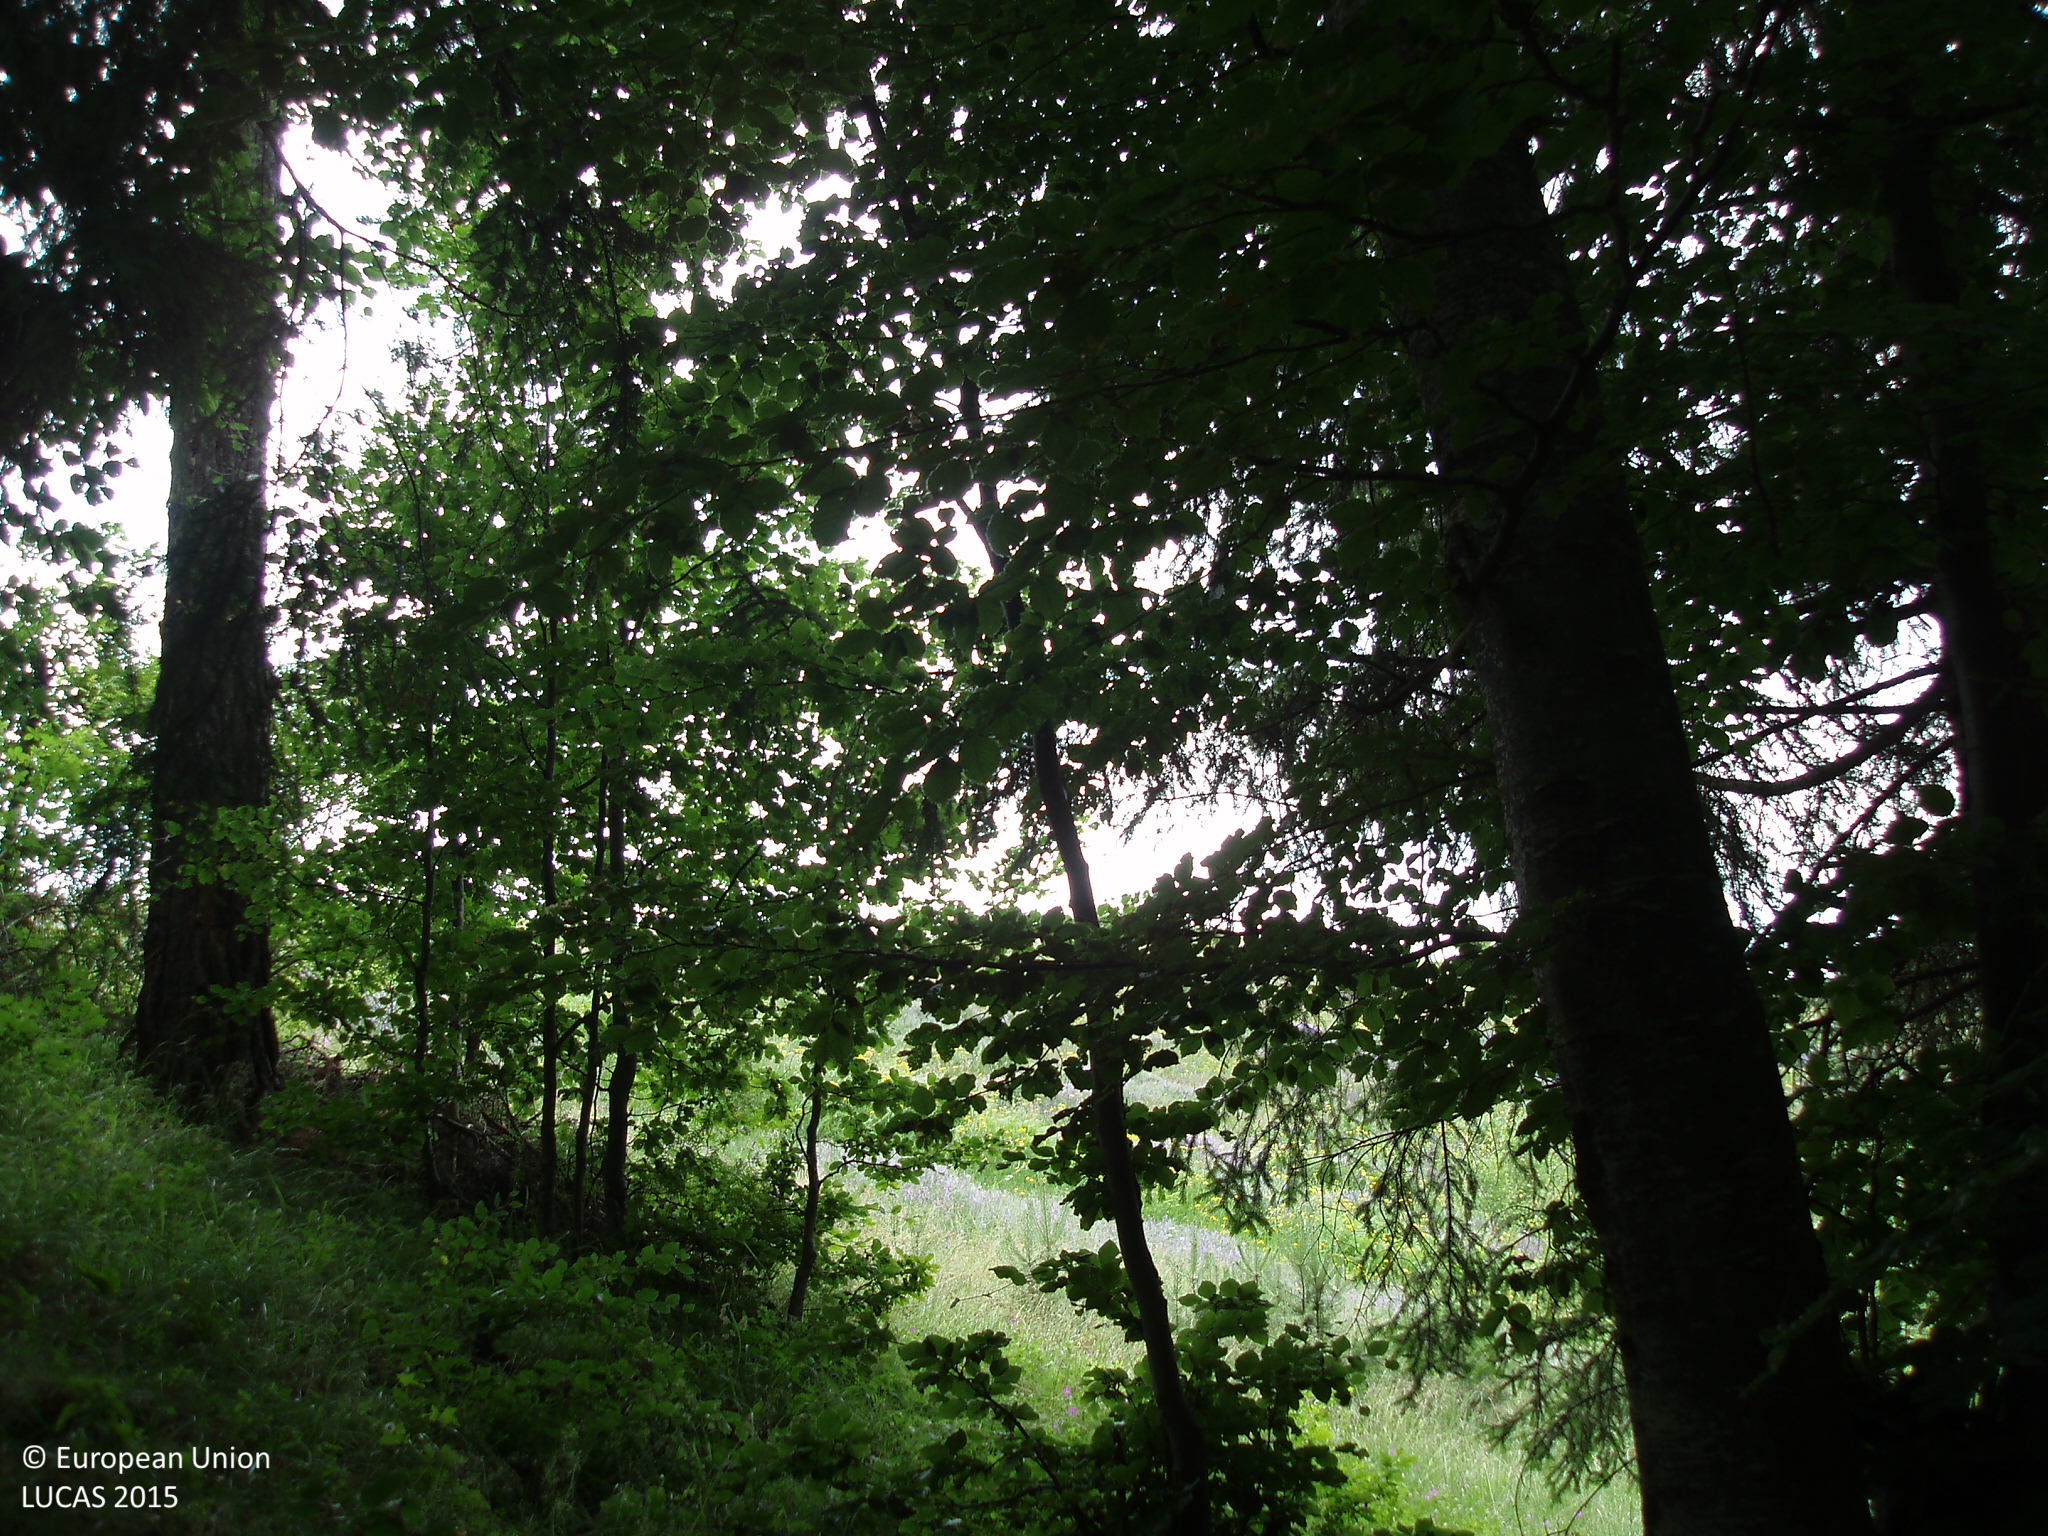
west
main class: Woodland
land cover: Pine dominated mixed woodland
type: hemiboreal forest and nemoral coniferous forest and mixed broadleaved-coniferous forest
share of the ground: > 75 %
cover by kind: coniferous forest trees 75 %, broadleaved forest trees 25 %
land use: Forestry
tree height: > 5 m
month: July
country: BG
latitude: 42.0458
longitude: 23.8444
